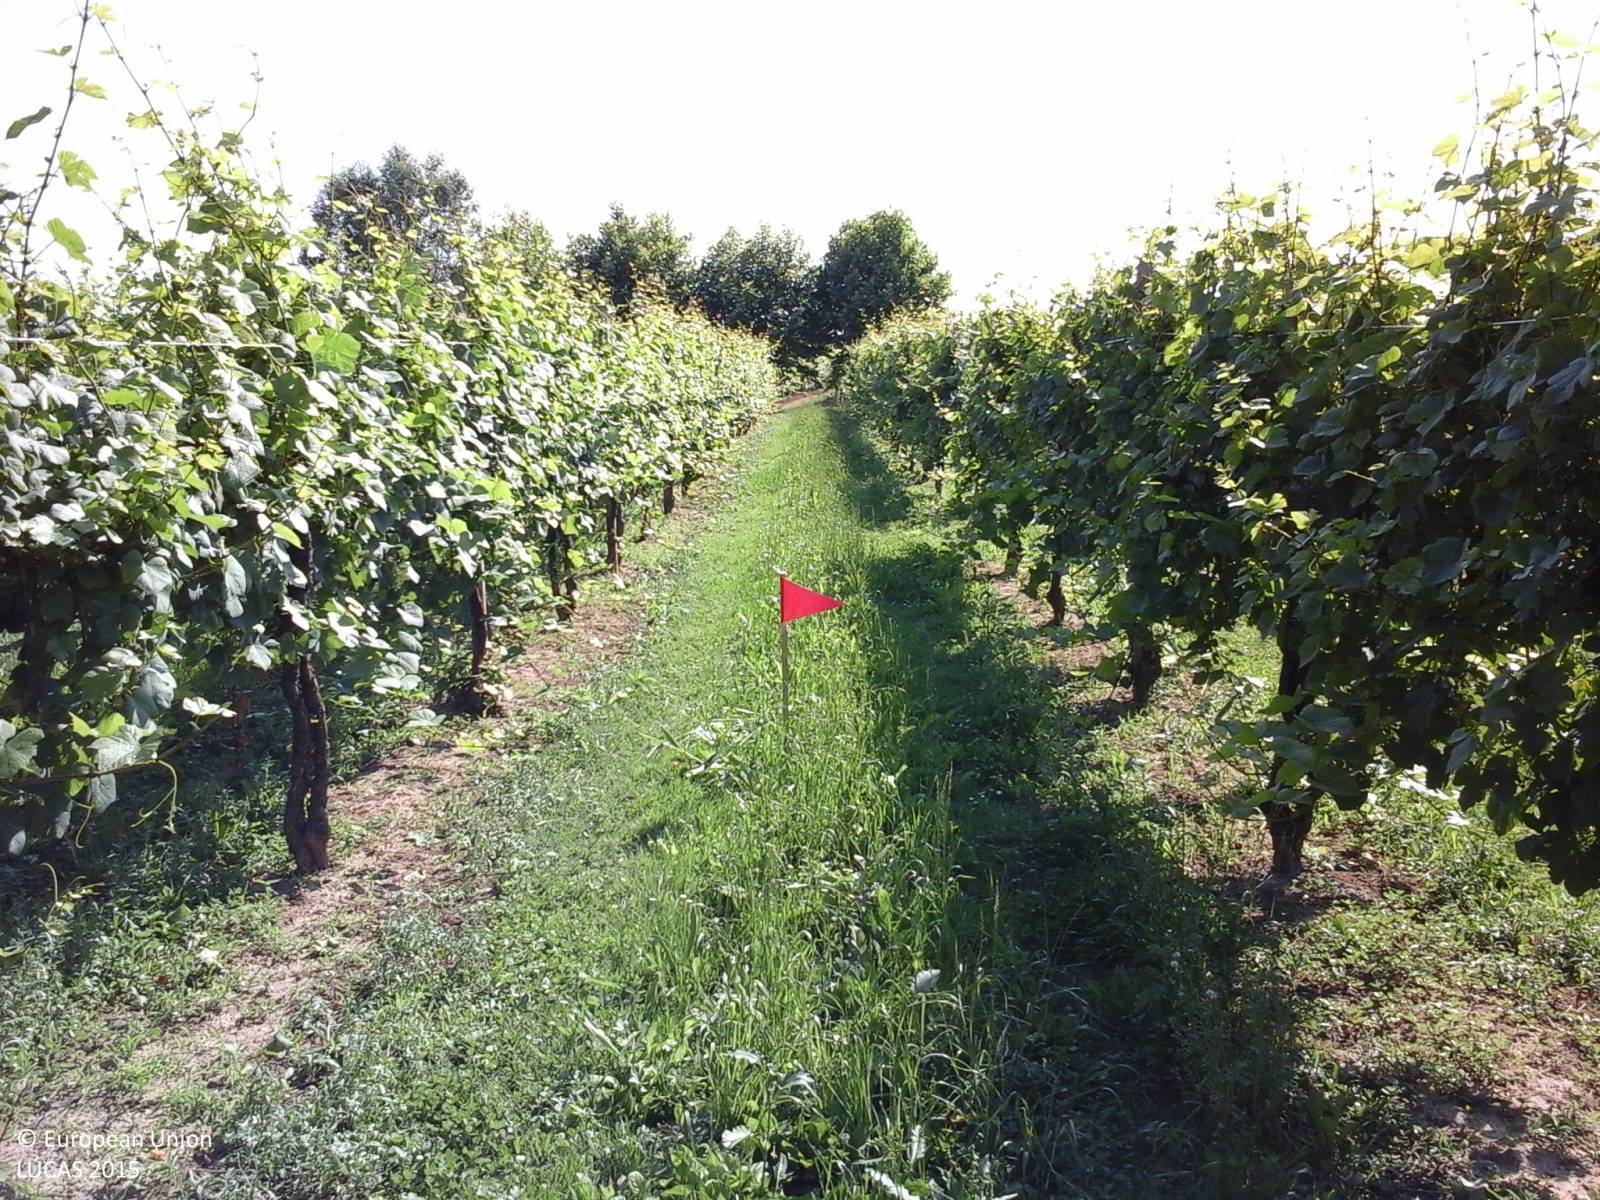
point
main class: Cropland
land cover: Vineyards
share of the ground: 50 - 75 %
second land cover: Grassland without tree/shrub cover
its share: 25 - 50 %
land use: Agriculture (excluding fallow land and kitchen gardens)
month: June
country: IT
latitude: 45.8122
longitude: 12.7118
